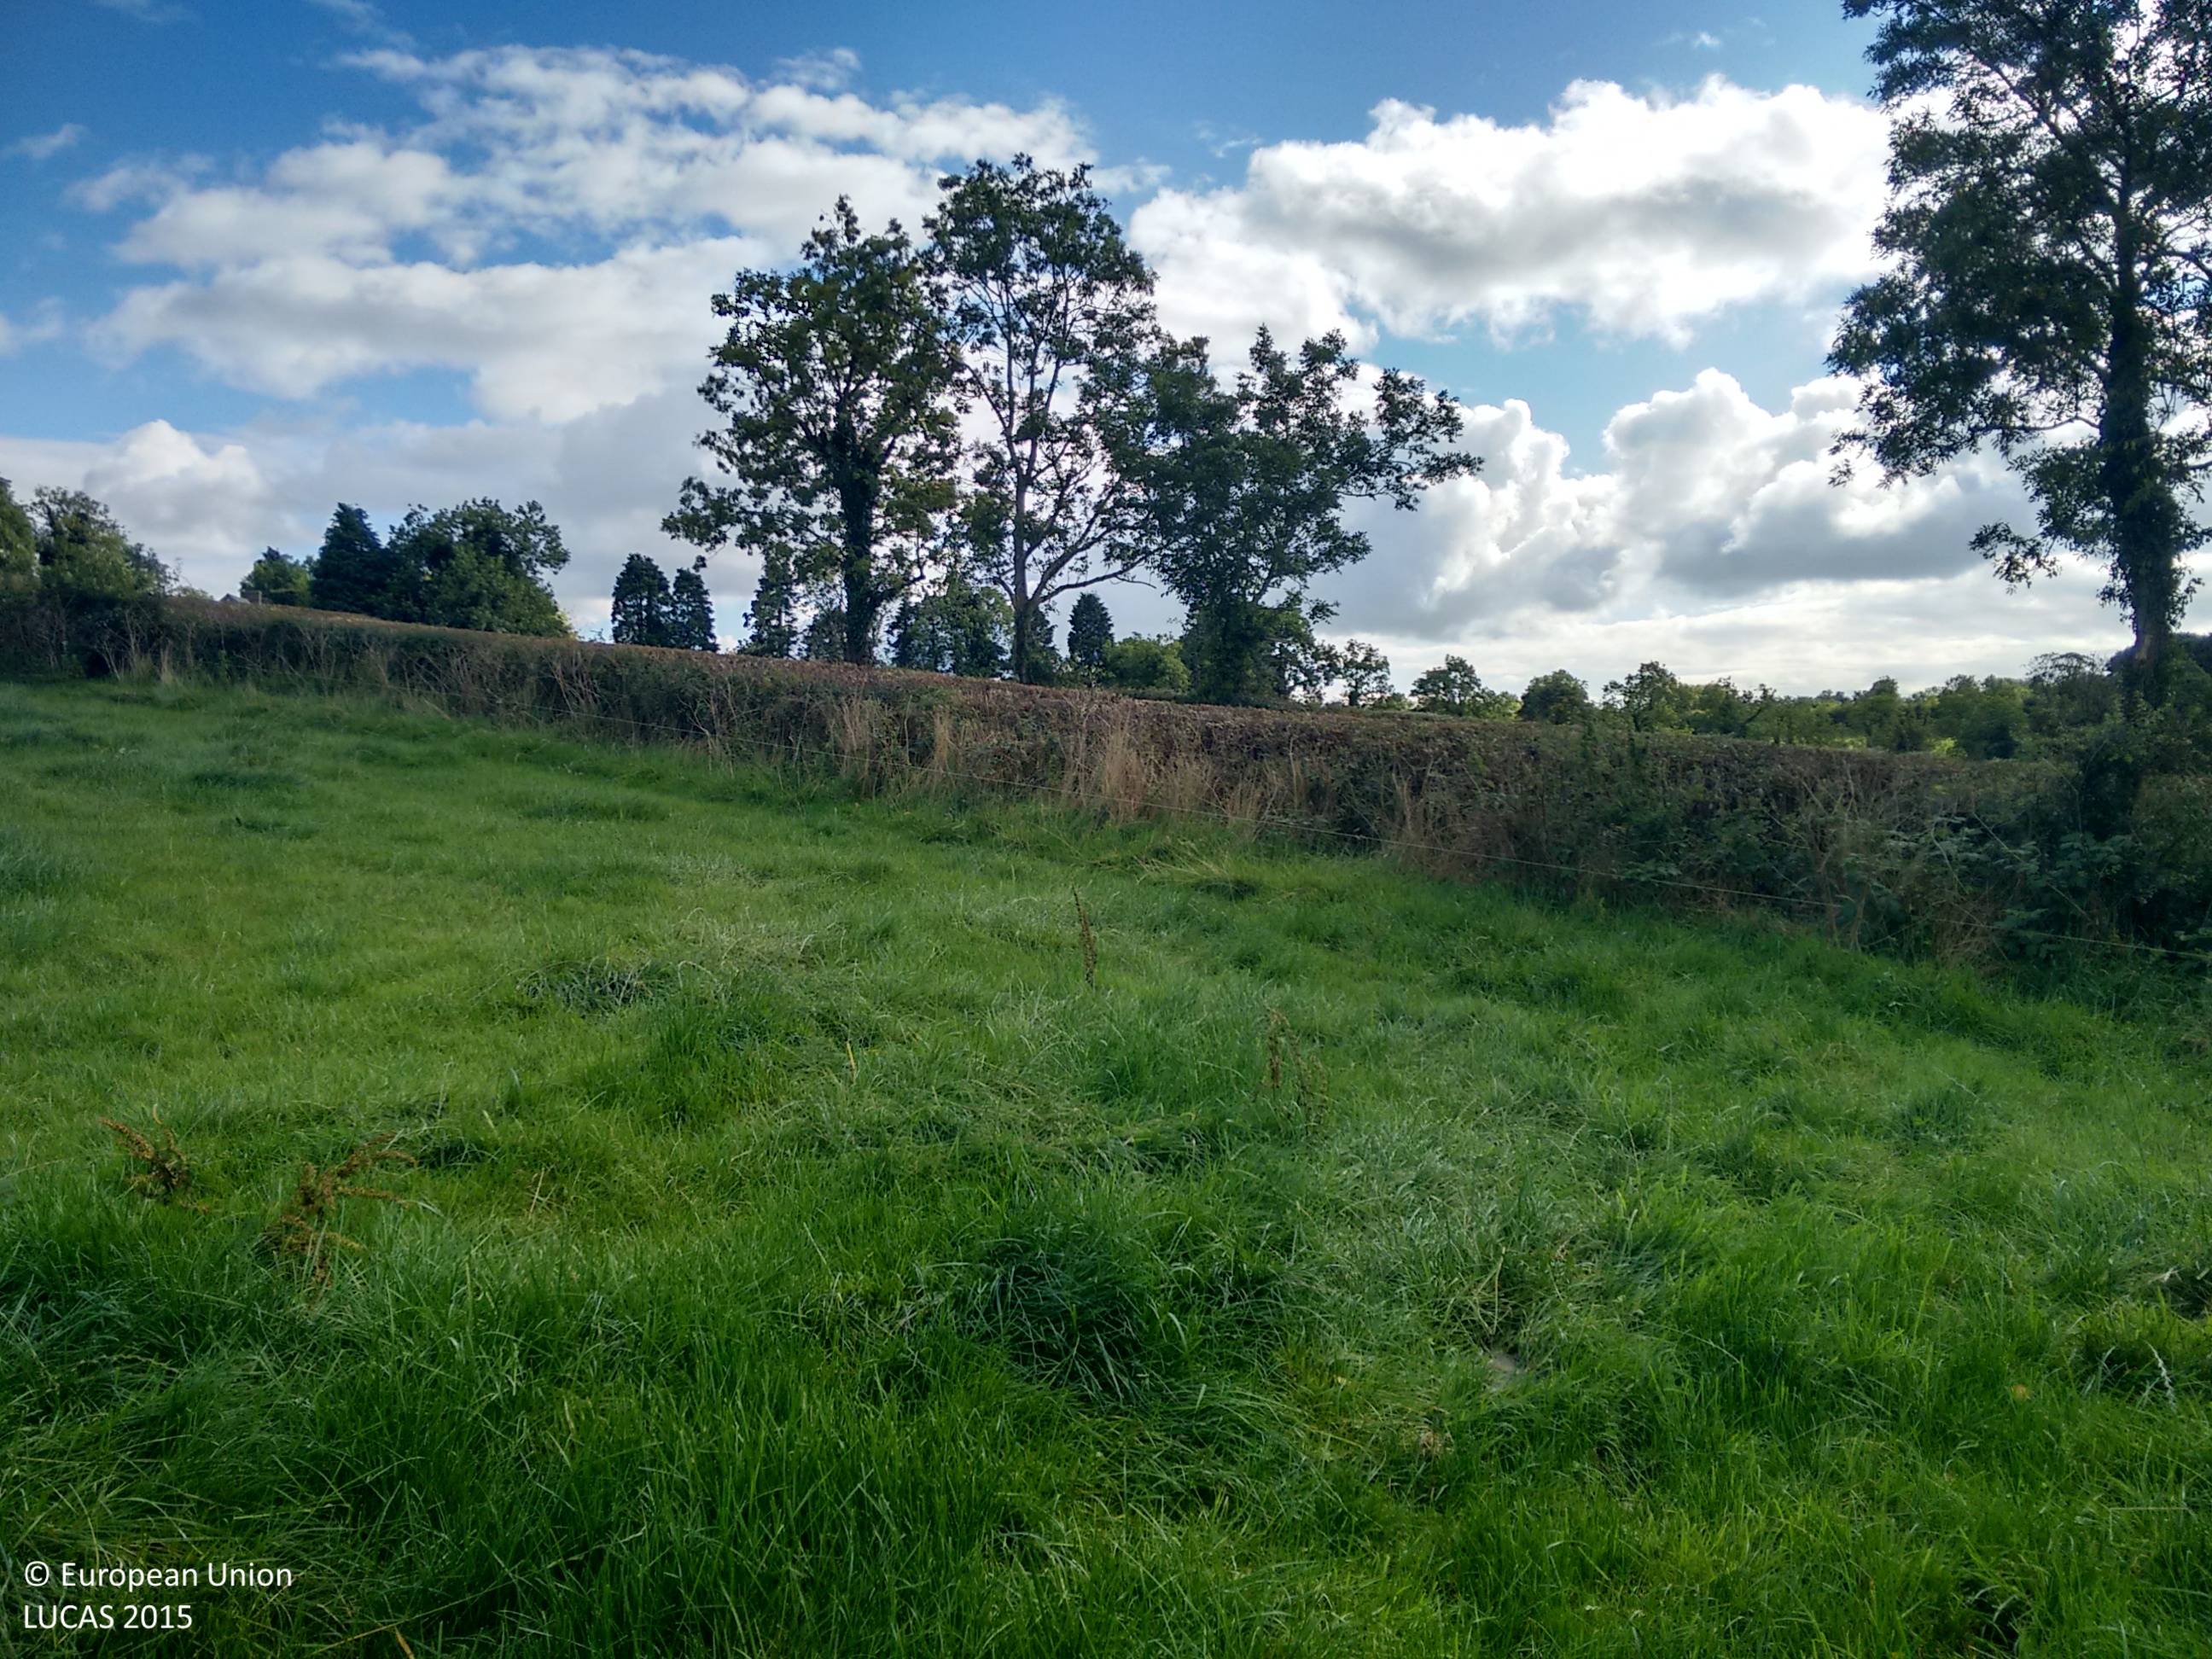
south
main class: Grassland
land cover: Grassland without tree/shrub cover
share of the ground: > 75 %
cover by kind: herbaceous plants 100 %
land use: Agriculture (excluding fallow land and kitchen gardens)
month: September
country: IE
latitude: 54.2119
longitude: -6.8652
